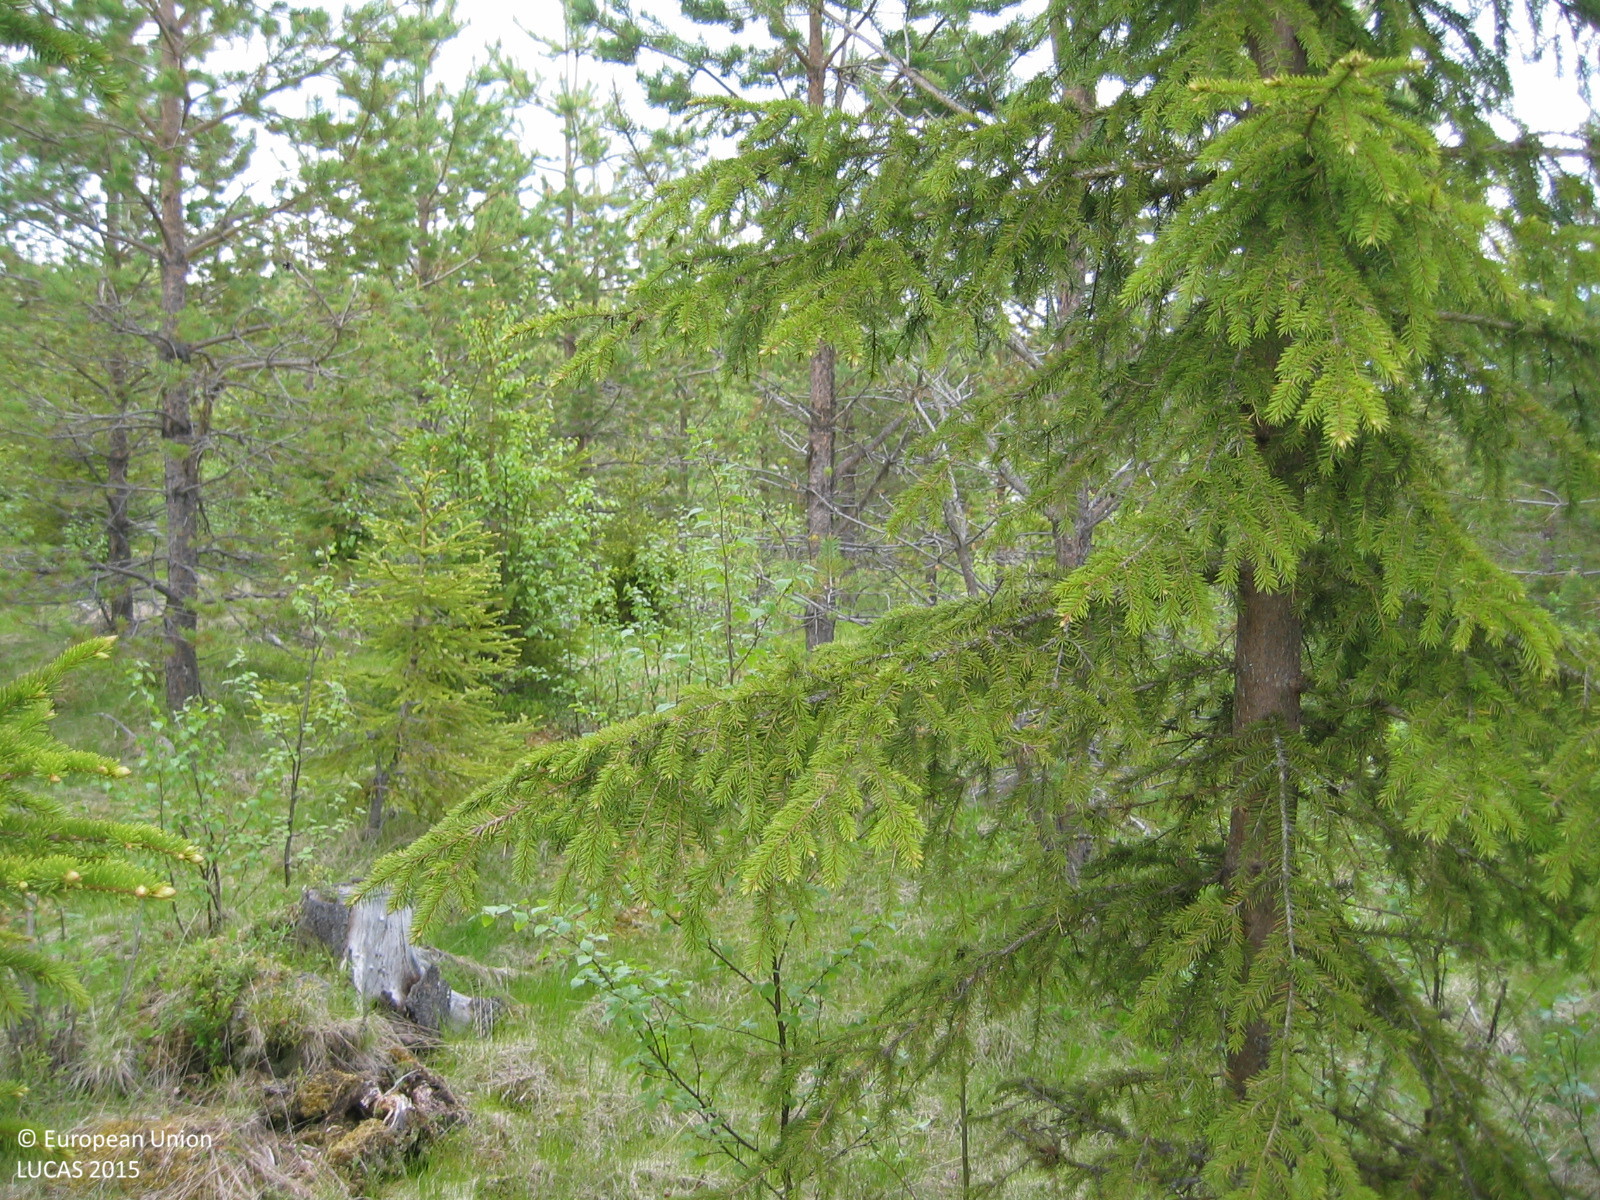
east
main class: Woodland
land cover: Other mixed woodland
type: boreal forest
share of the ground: 50 - 75 %
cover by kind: coniferous forest trees 50 %, broadleaved forest trees 25 %, herbaceous plants 25 %
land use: Forestry
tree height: < 5 m
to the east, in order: Other mixed woodland; Spruce dominated coniferous woodland; Pine dominated coniferous woodland; Grass margins; Paved roads, cycling and walking lanes; Grass margins; Spruce dominated coniferous woodland
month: June
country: SE
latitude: 63.5351
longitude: 14.6233
